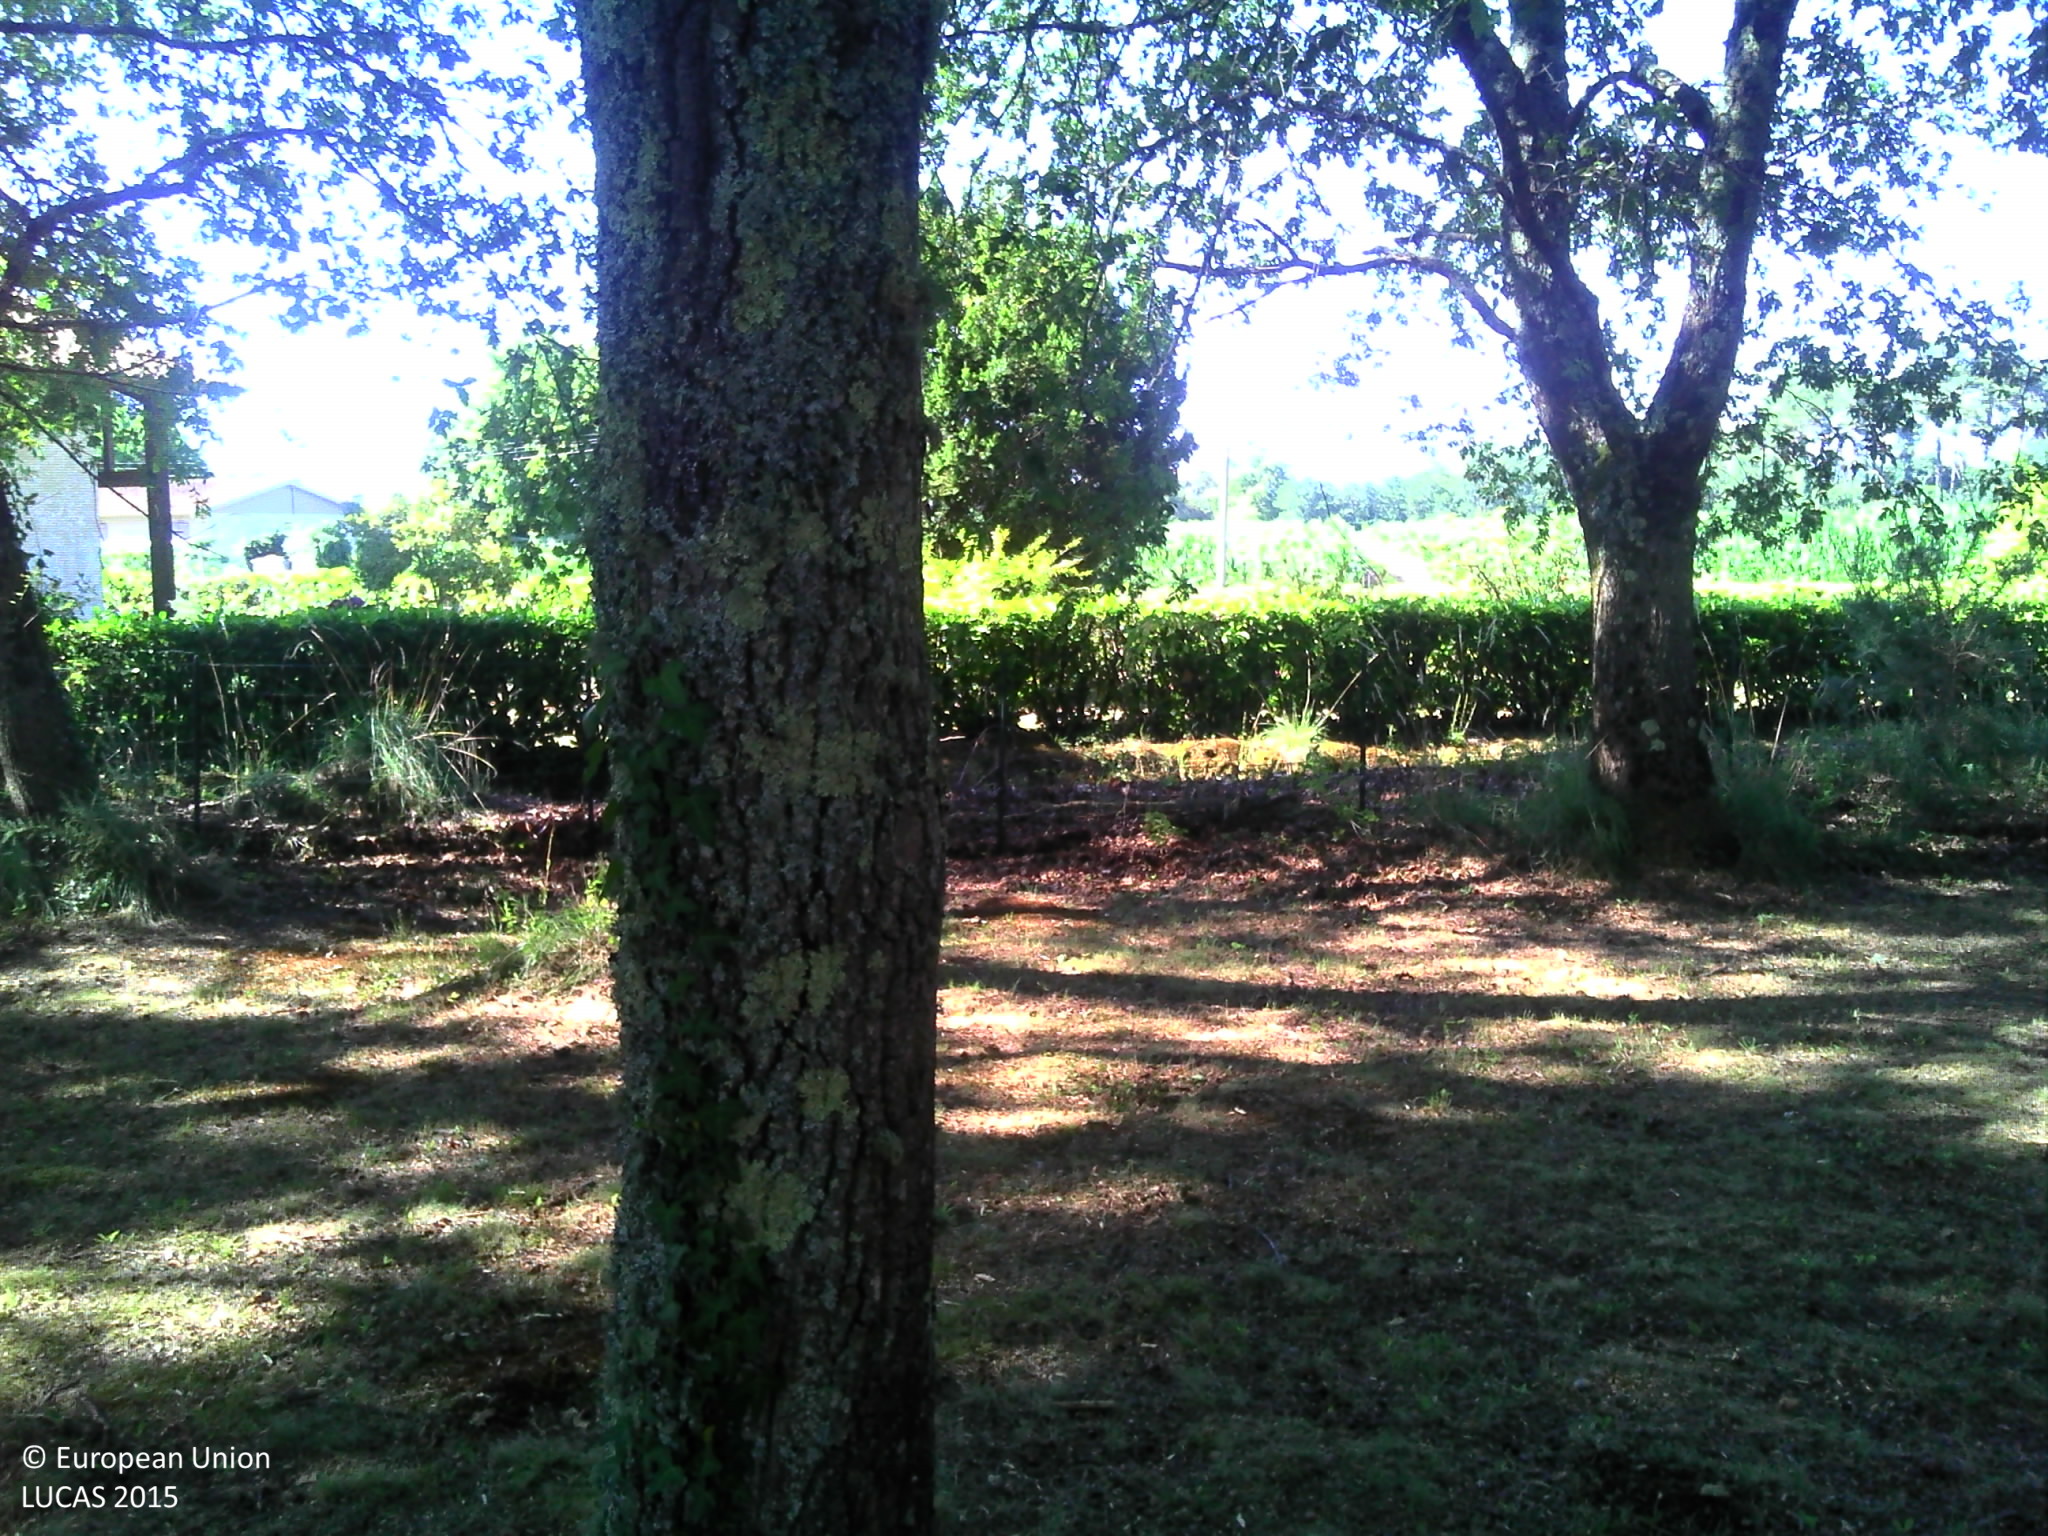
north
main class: Woodland
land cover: Broadleaved woodland
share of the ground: > 75 %
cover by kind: broadleaved forest trees 100 %
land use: Residential
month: July
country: FR
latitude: 43.9676
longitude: -0.6204
